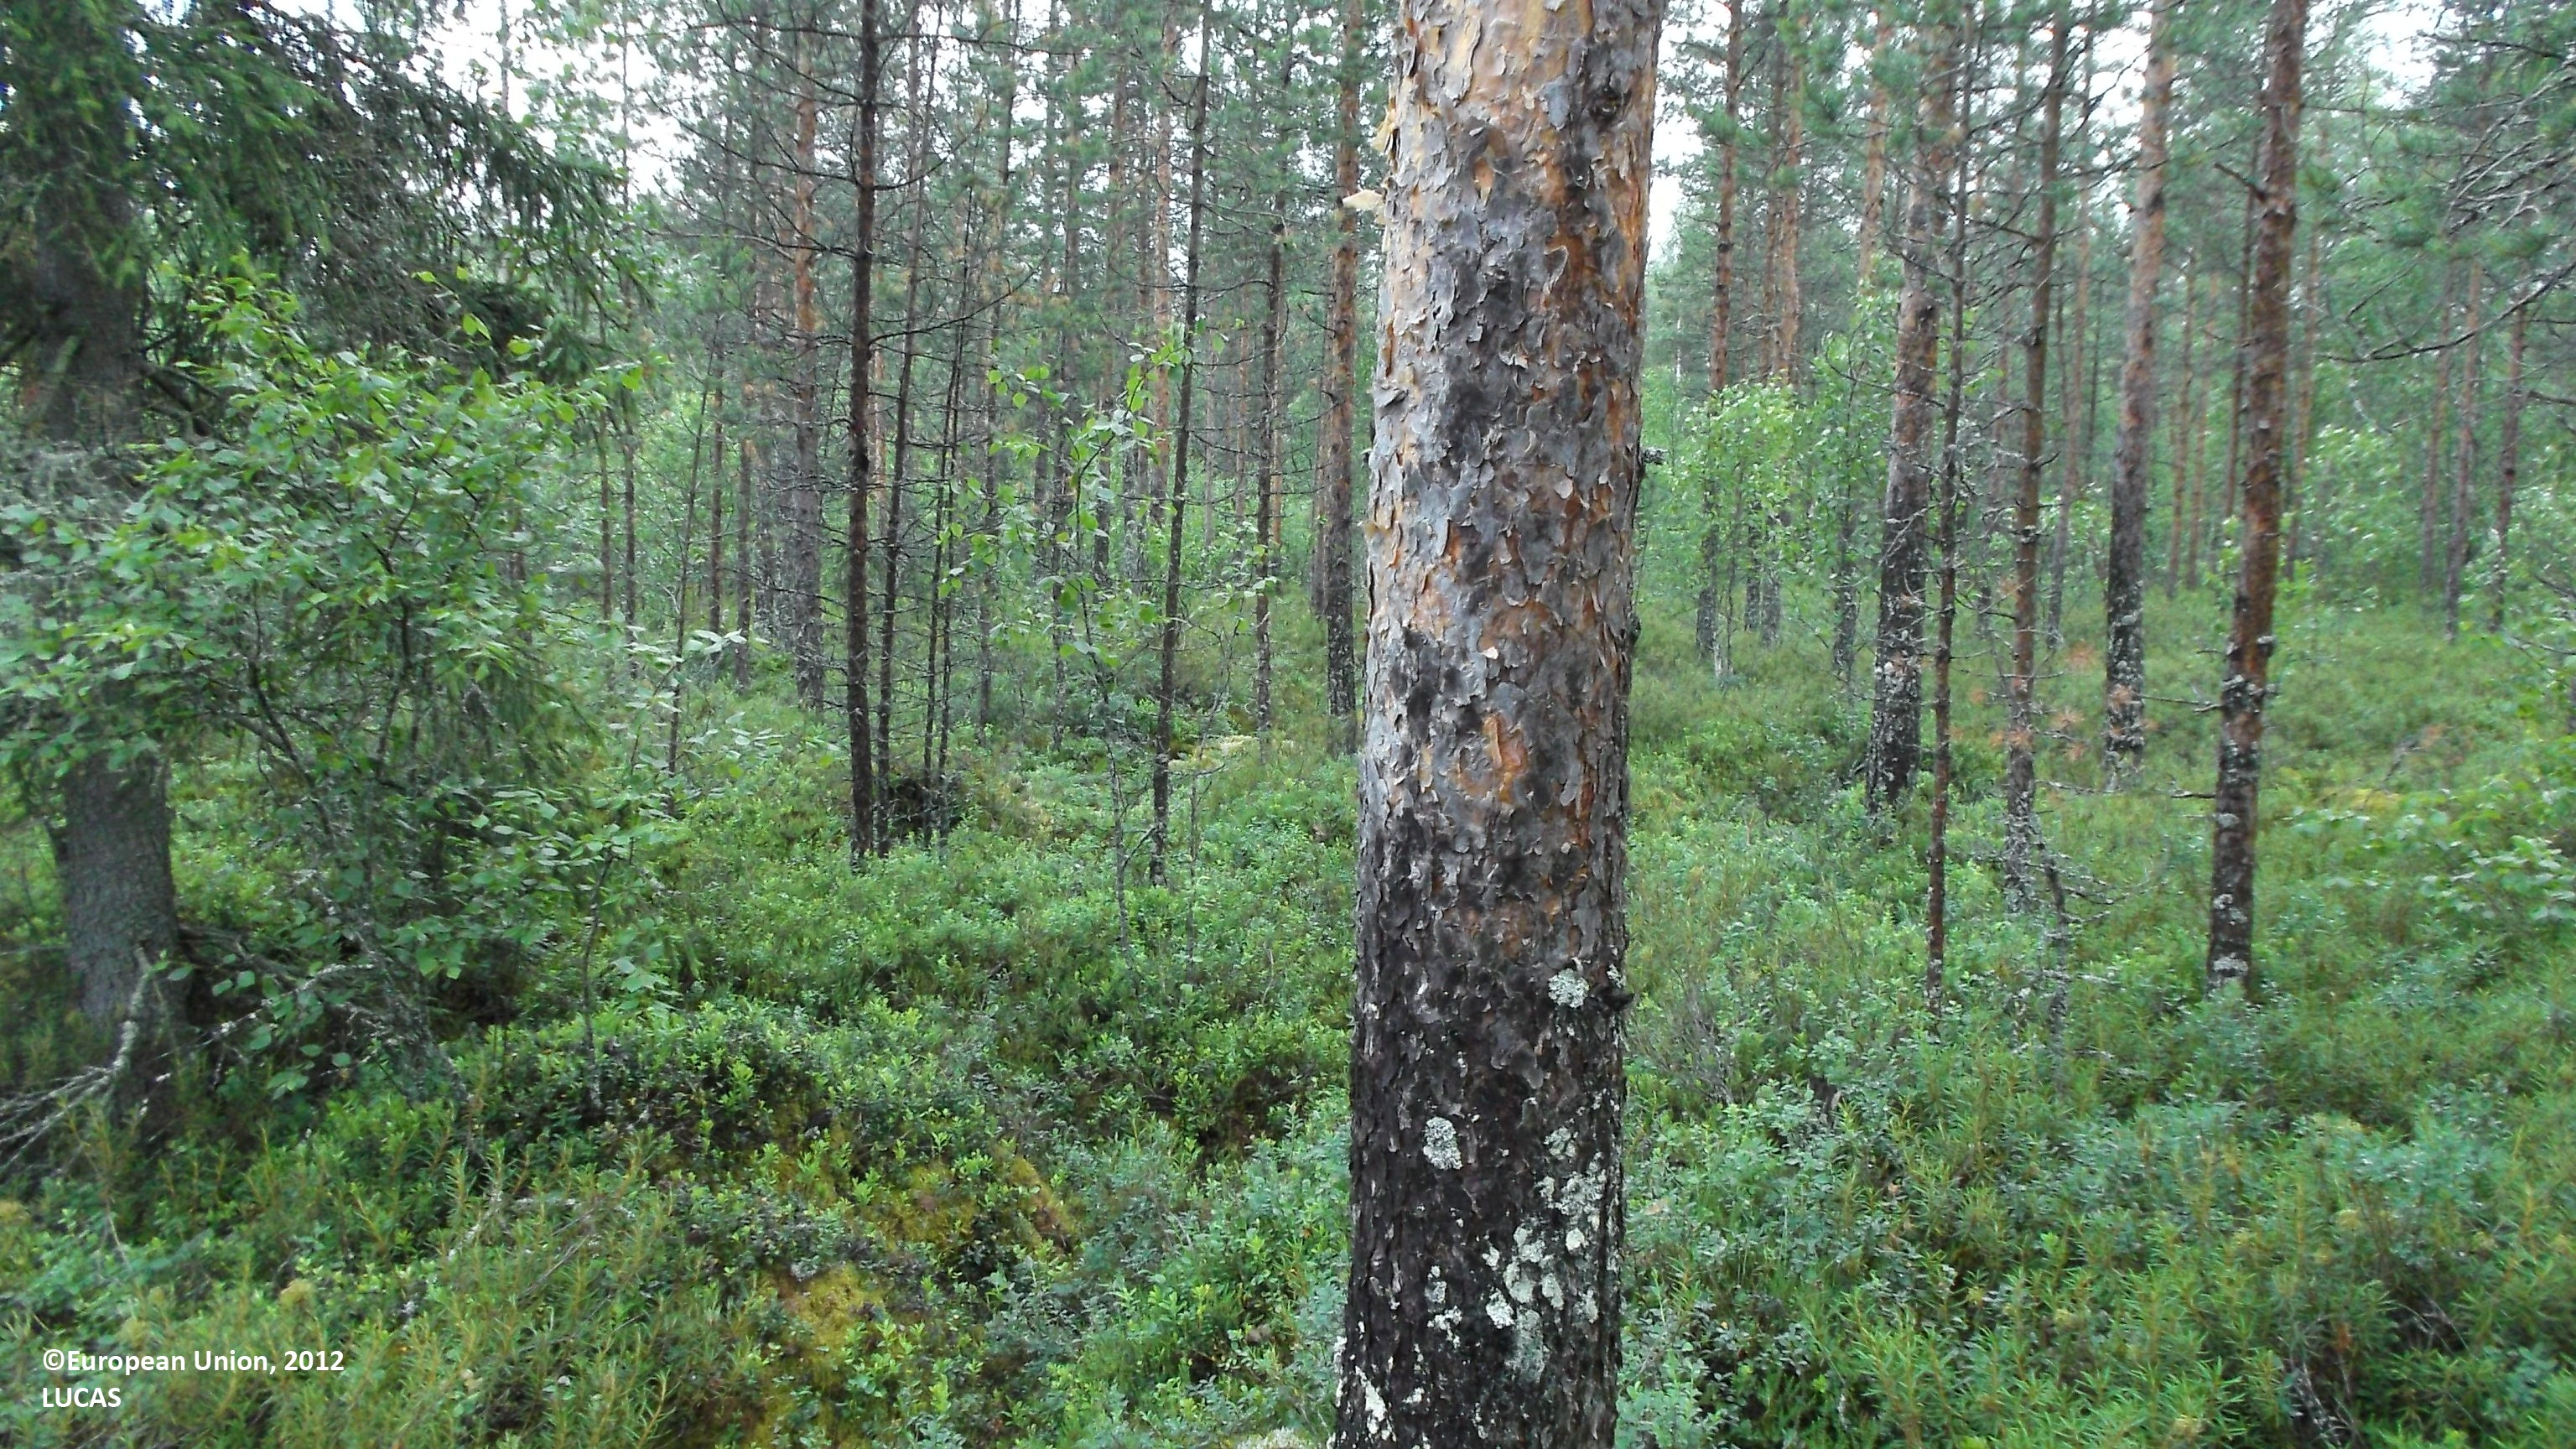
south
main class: Woodland
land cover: Other mixed woodland
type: boreal forest
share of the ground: 50 - 75 %
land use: Forestry
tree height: > 5 m
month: July
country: FI
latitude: 63.3928
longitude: 23.9394
